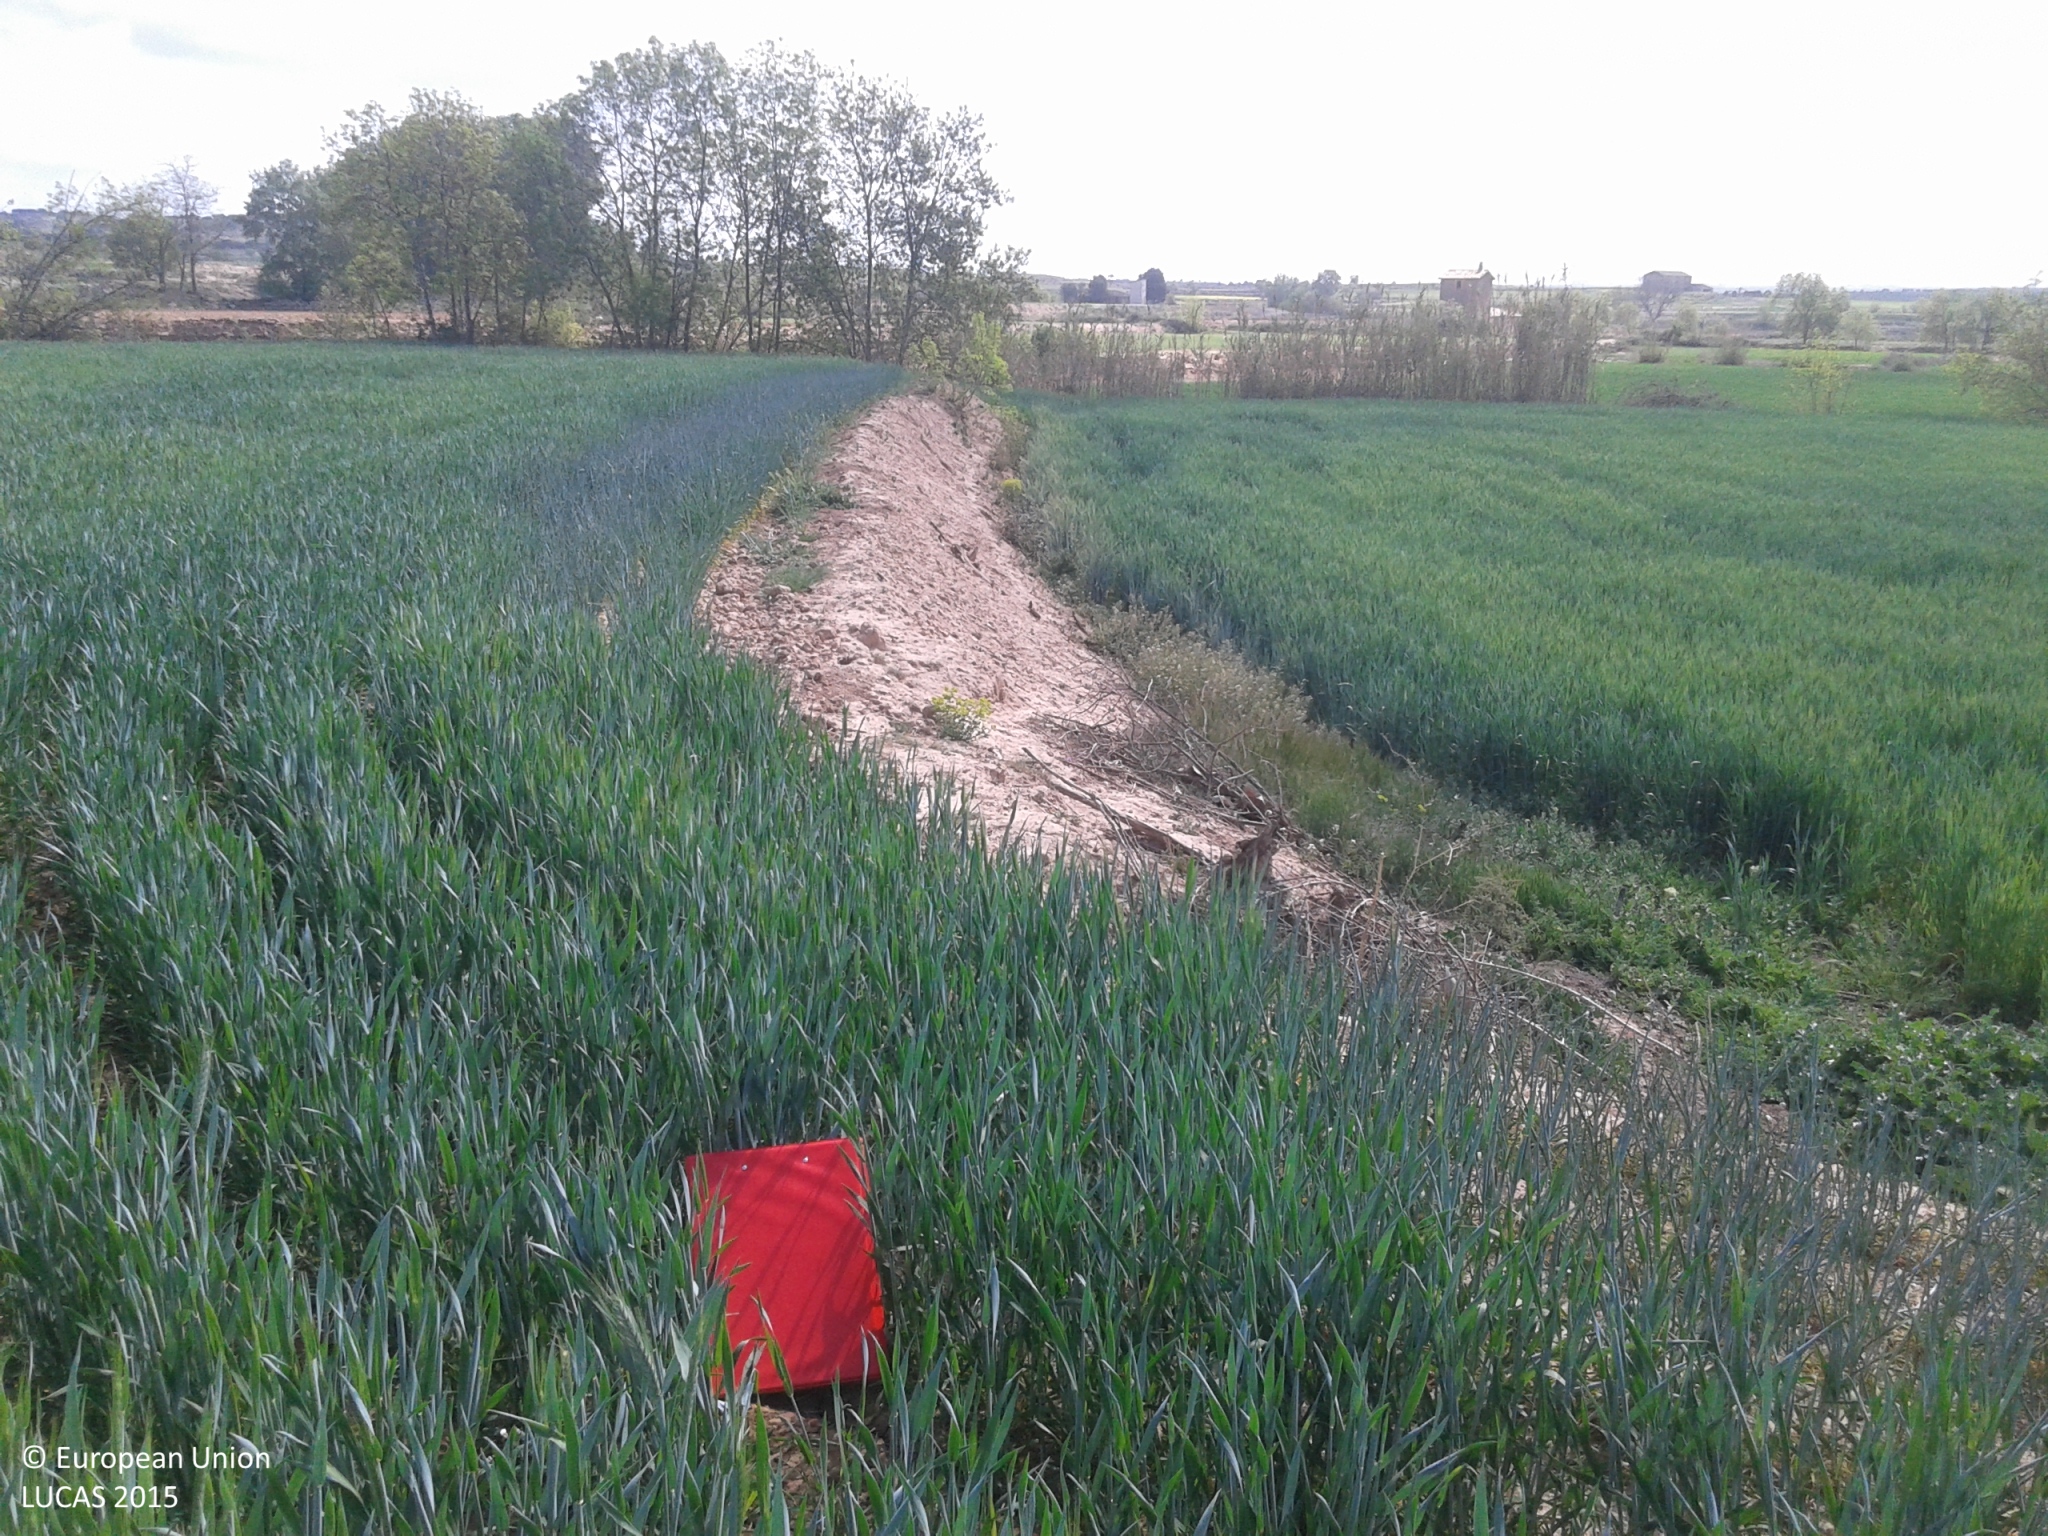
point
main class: Cropland
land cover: Oats
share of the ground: > 75 %
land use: Agriculture (excluding fallow land and kitchen gardens)
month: April
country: ES
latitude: 41.7352
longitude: 1.1037
